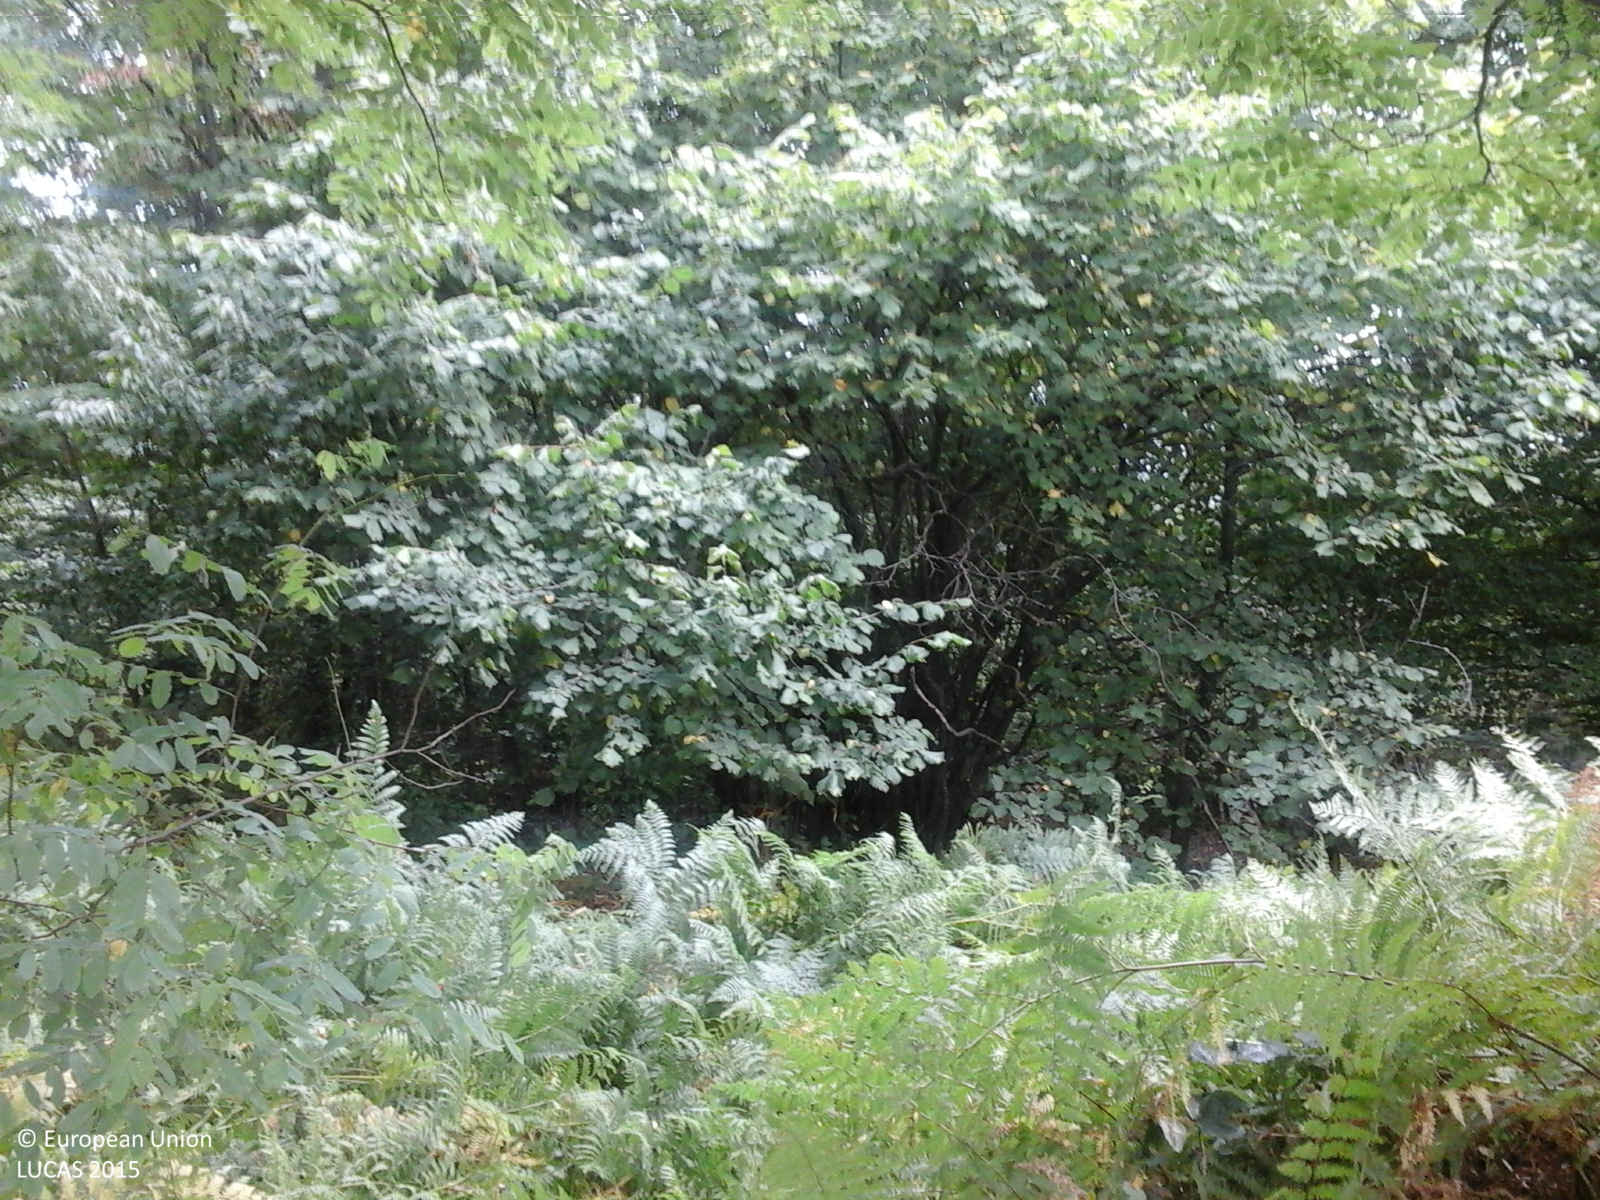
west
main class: Woodland
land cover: Broadleaved woodland
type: broadleaved evergreen forest
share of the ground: > 75 %
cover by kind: broadleaved forest trees 100 %
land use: Forestry
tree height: > 5 m
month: August
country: RO
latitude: 45.2065
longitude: 21.9400
